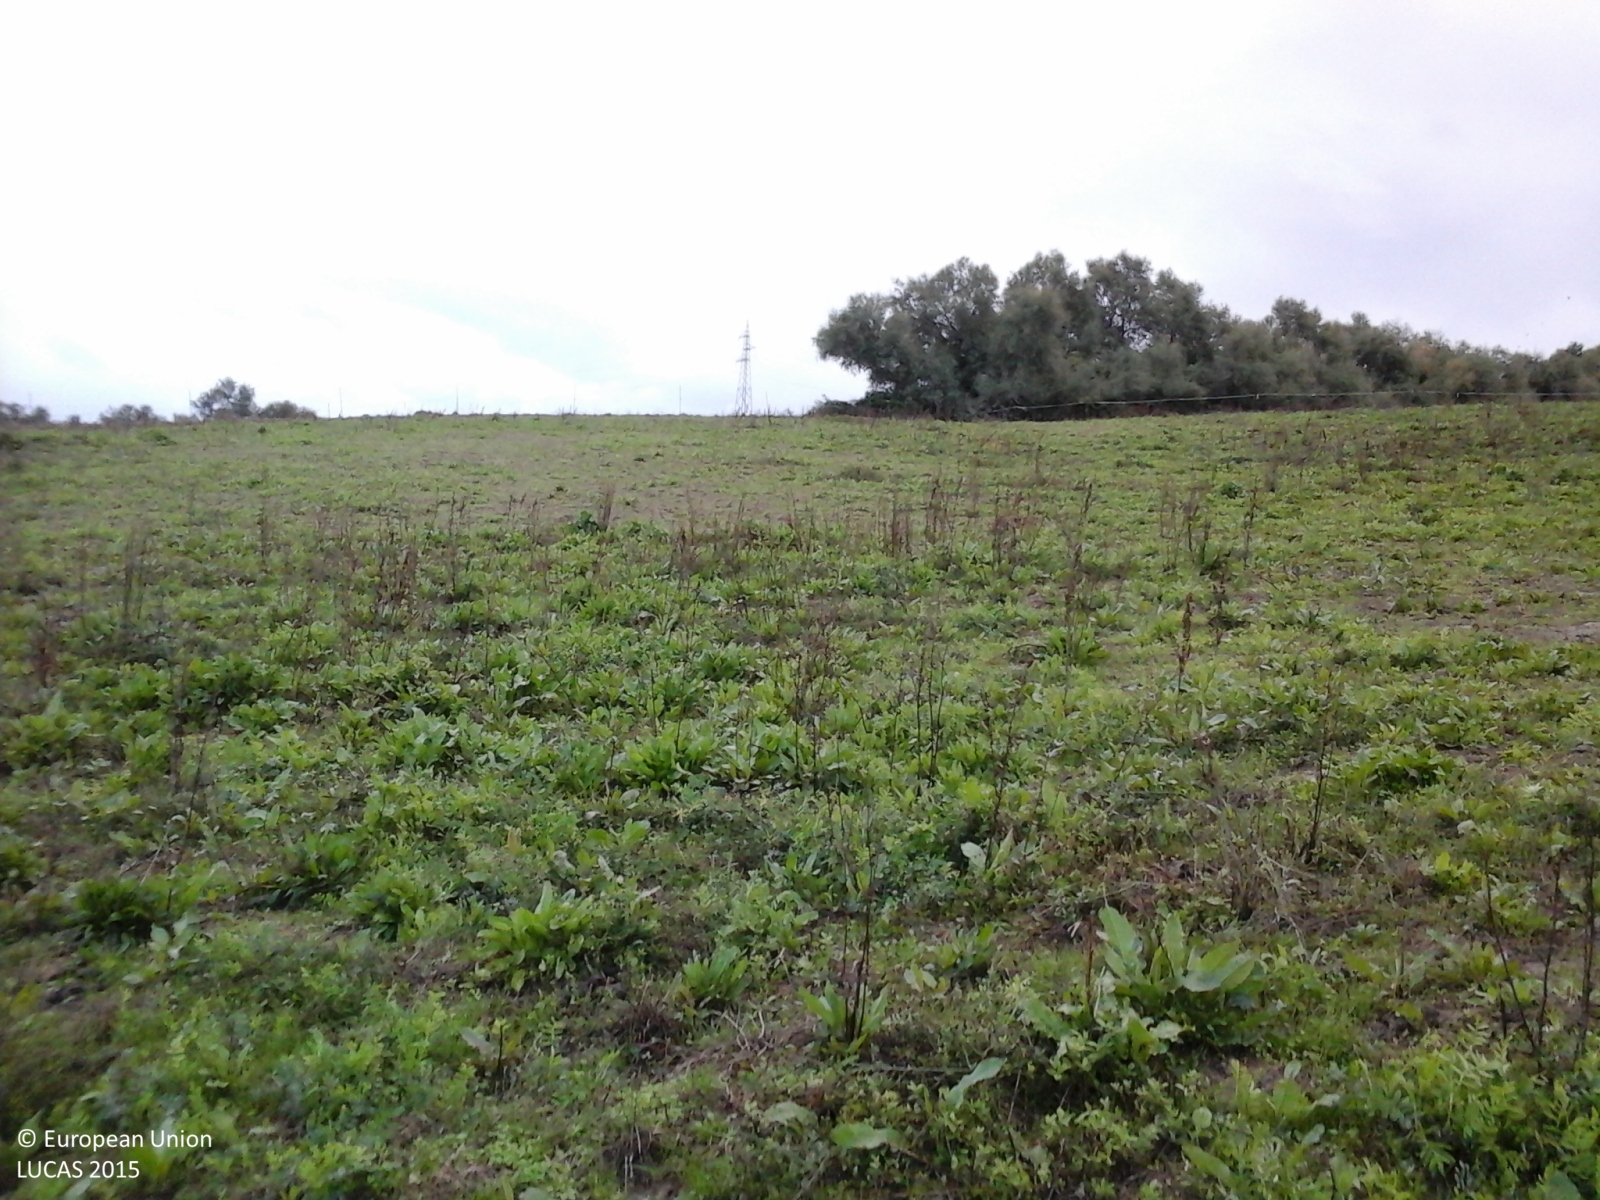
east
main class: Grassland
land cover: Grassland without tree/shrub cover
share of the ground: > 75 %
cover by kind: herbaceous plants 100 %
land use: Agriculture (excluding fallow land and kitchen gardens)
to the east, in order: Grassland without tree/shrub cover; Durum wheat; Abandoned hedges
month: October
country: IT
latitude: 43.6088
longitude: 13.3991
